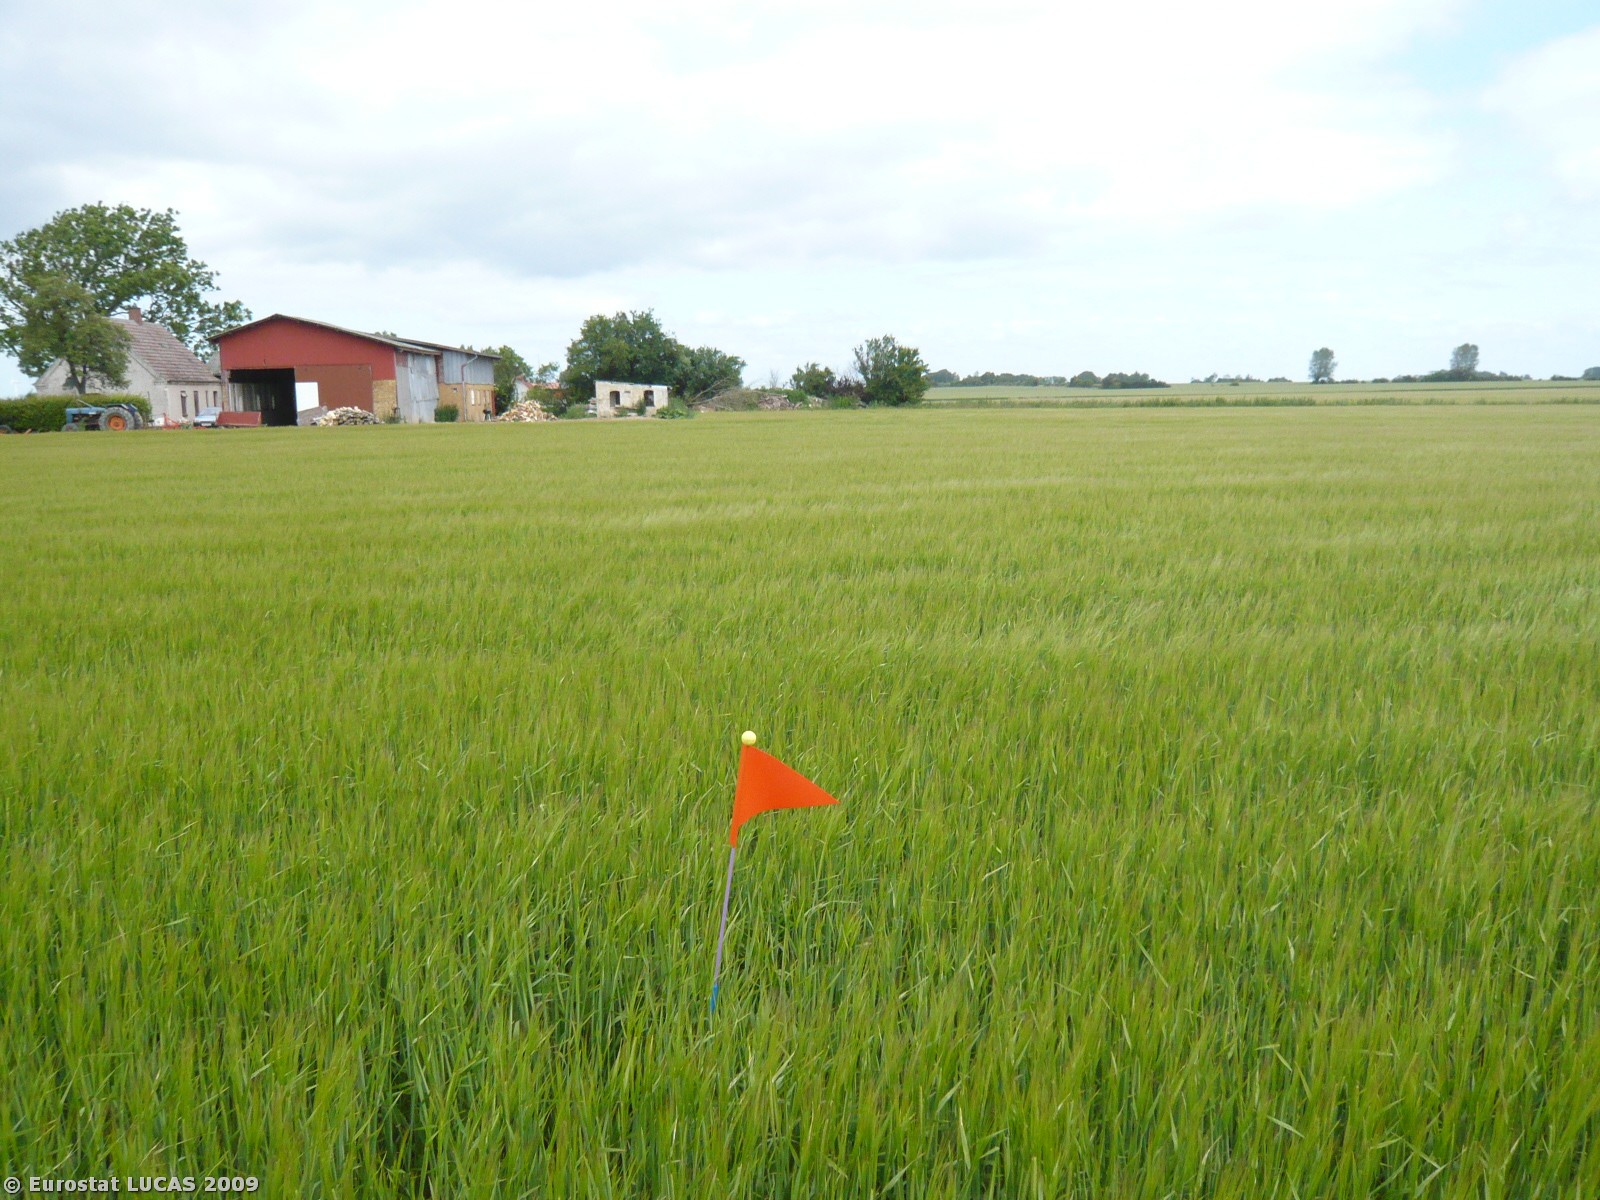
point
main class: Cropland
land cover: Barley
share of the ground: > 75 %
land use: Agriculture (excluding fallow land and kitchen gardens)
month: June
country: DK
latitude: 54.9415
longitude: 11.2323
